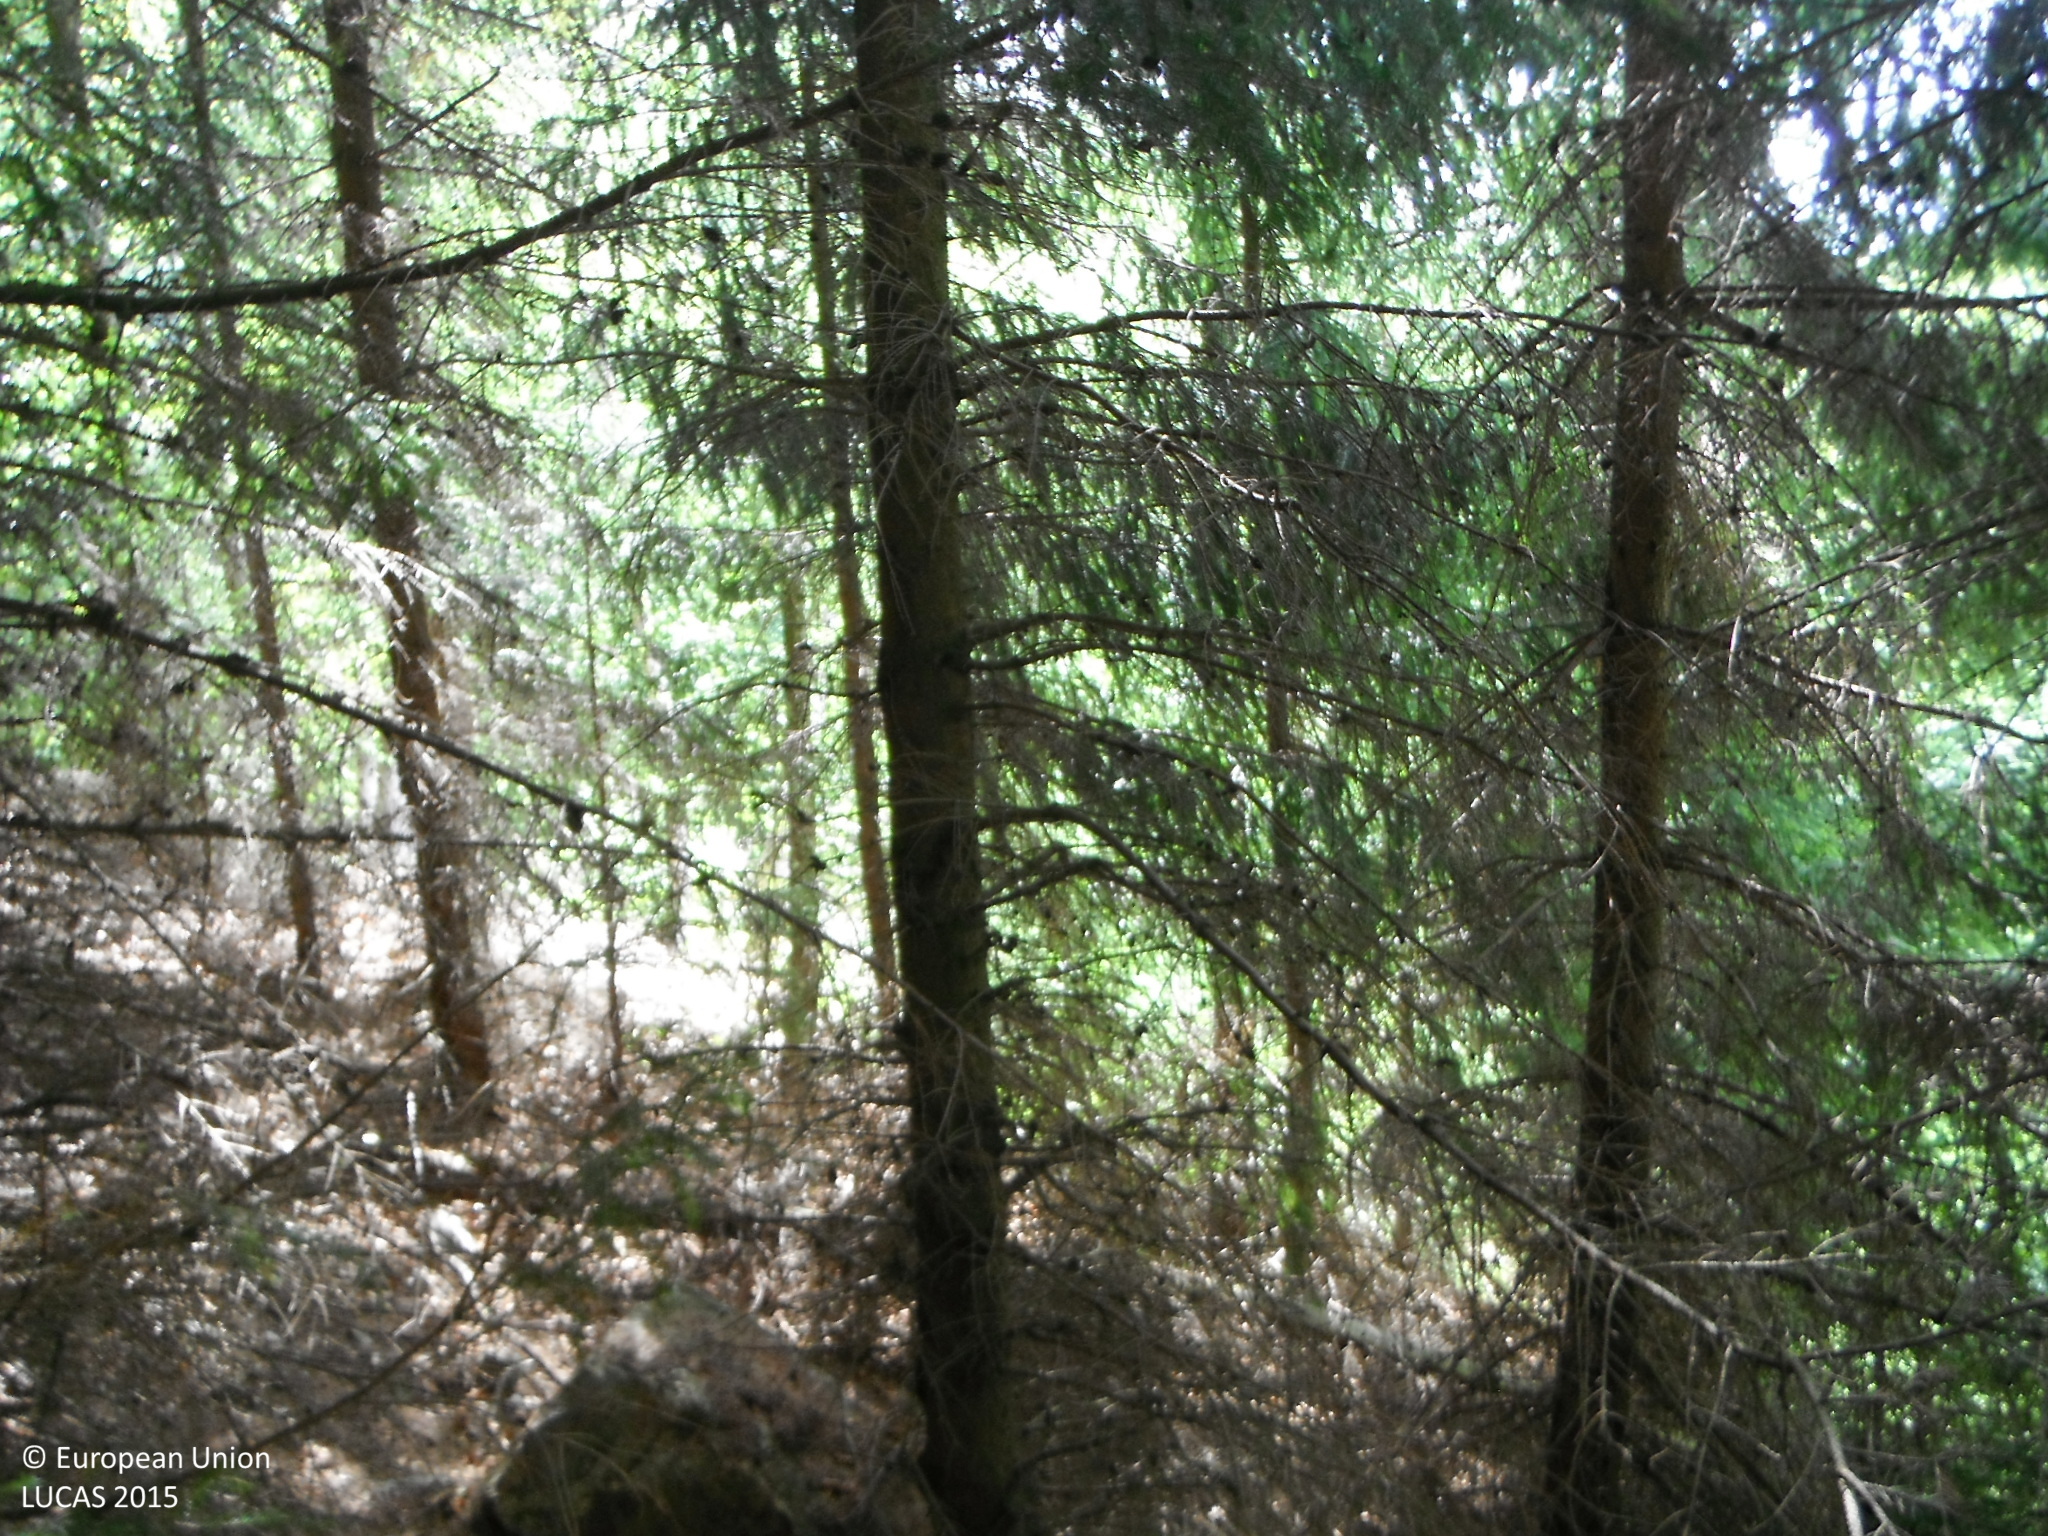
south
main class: Woodland
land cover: Other coniferous woodland
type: alpine coniferous forest
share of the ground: > 75 %
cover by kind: coniferous forest trees 80 %, broadleaved forest trees 10 %, unconsolidated bare surface 10 %
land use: Forestry
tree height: > 5 m
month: September
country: SK
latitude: 48.7622
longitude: 18.0270
